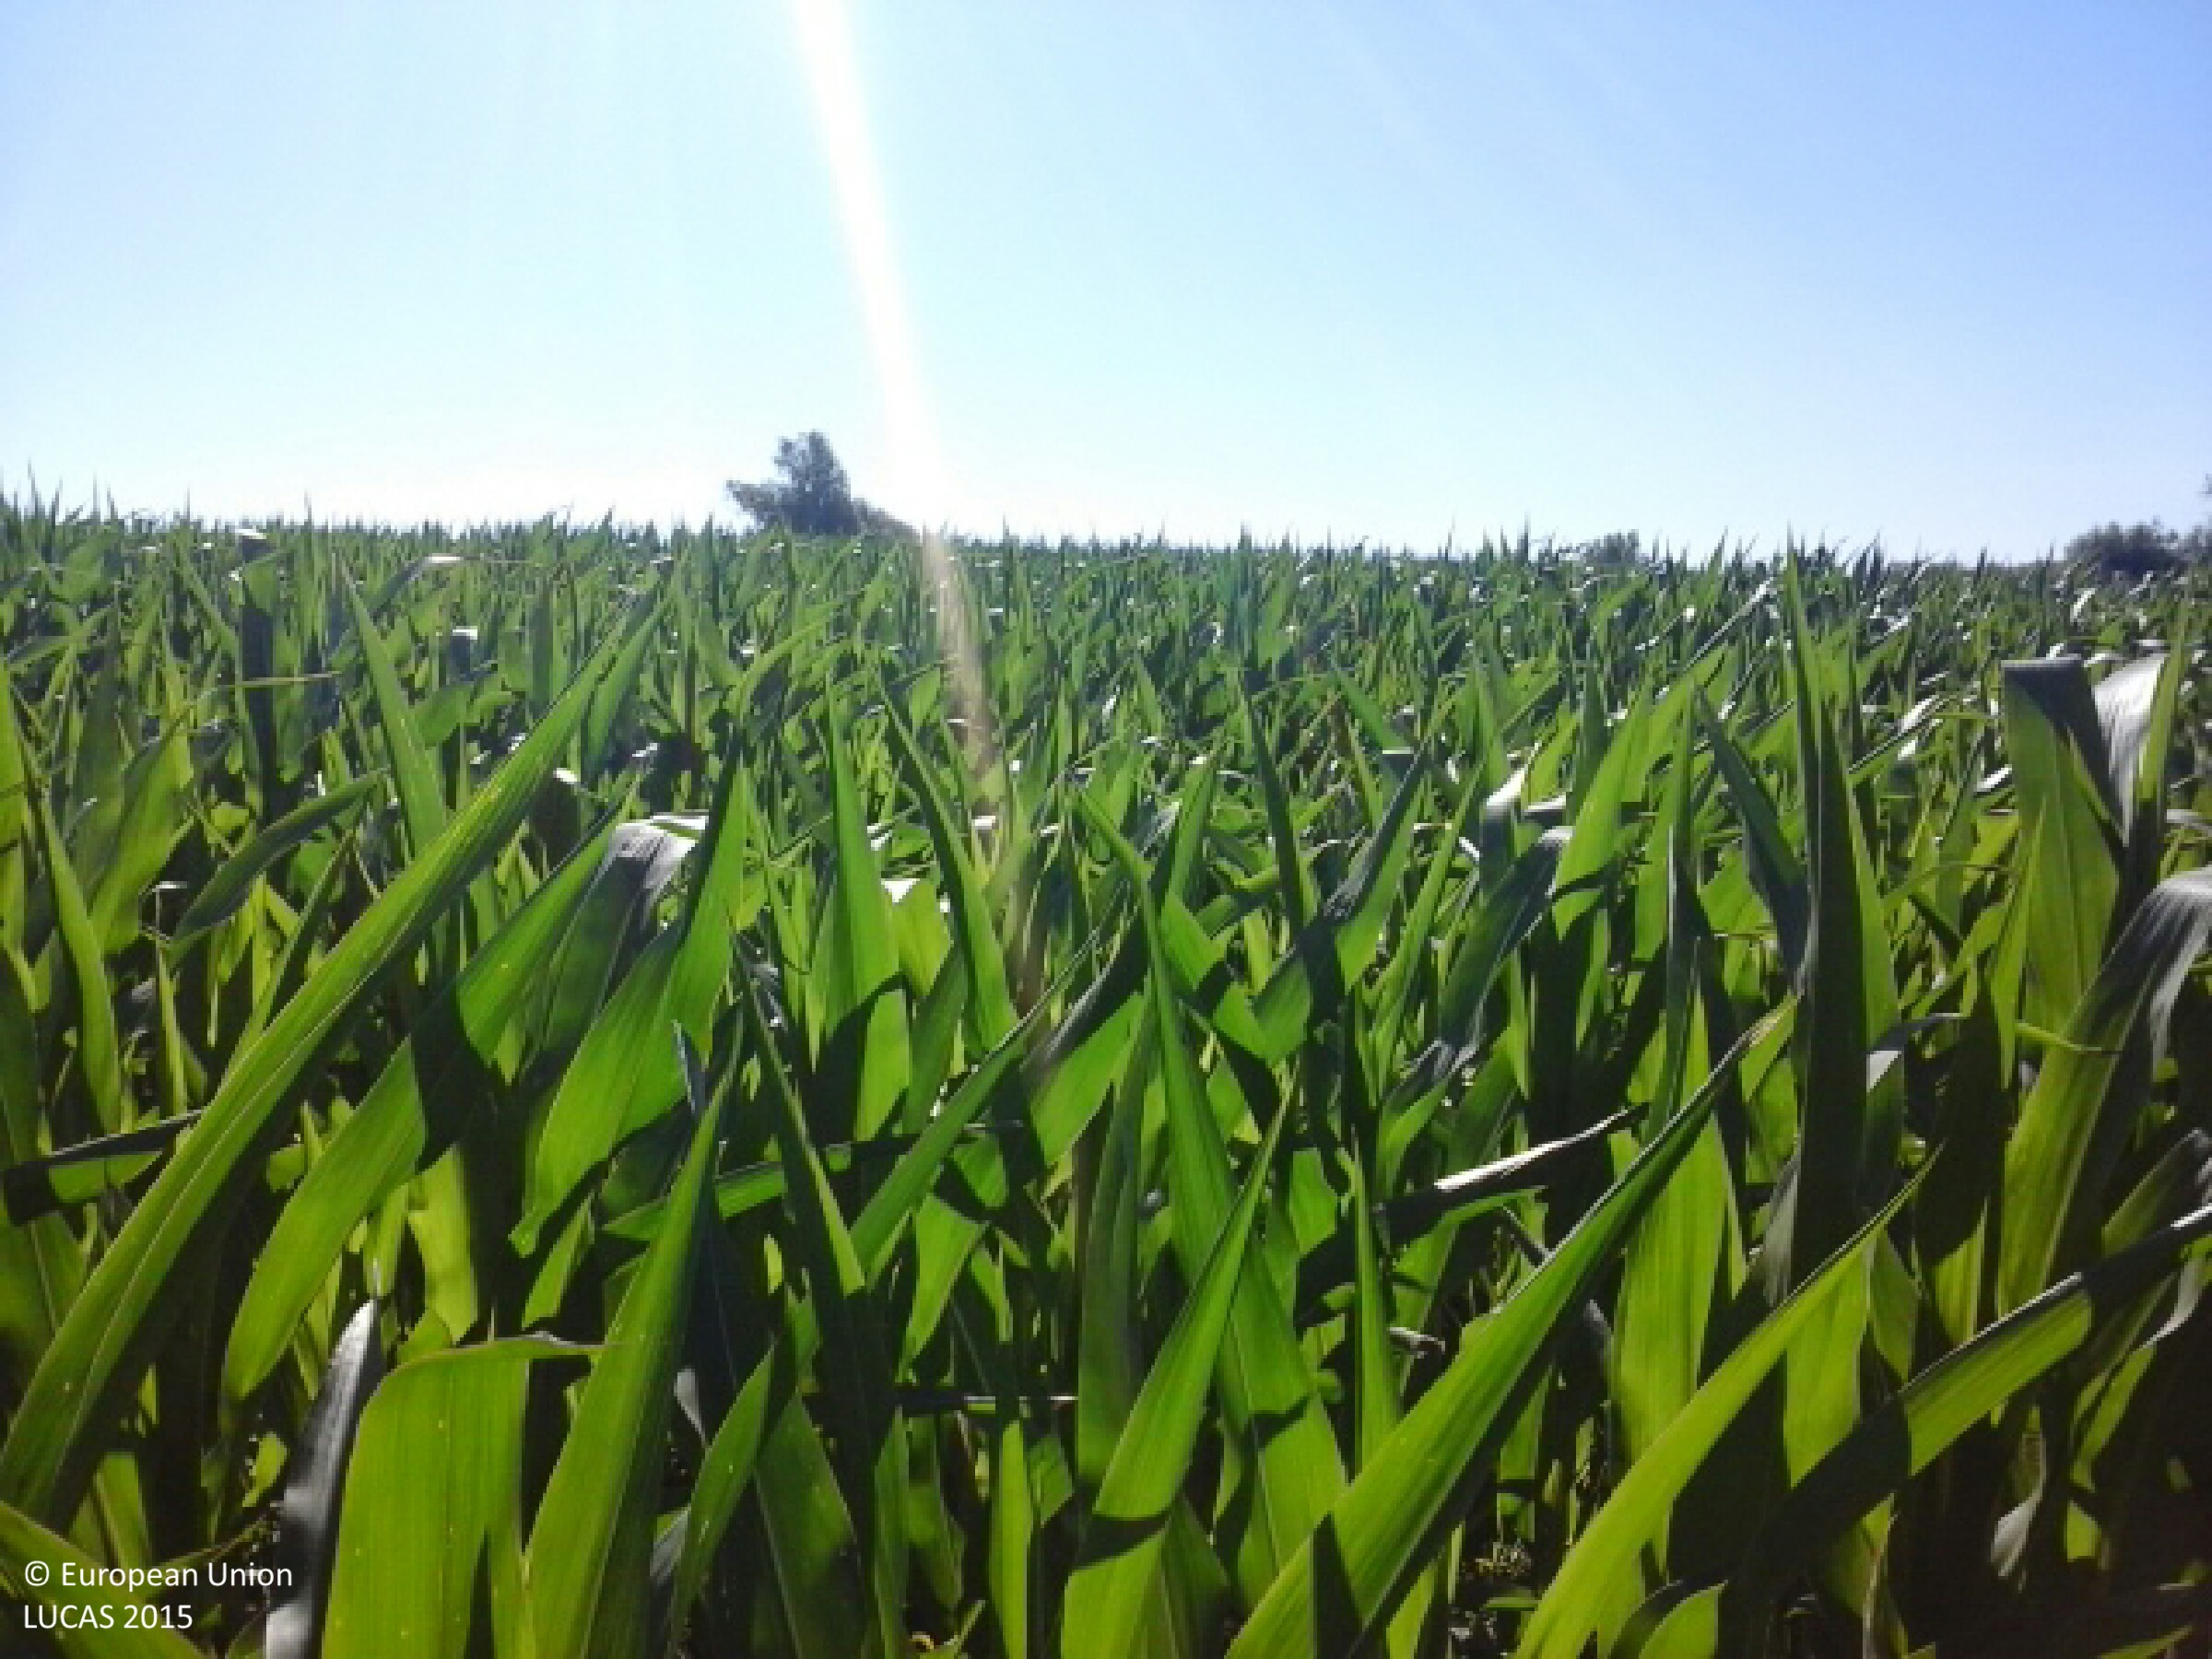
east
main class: Cropland
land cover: Maize
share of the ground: > 75 %
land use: Agriculture (excluding fallow land and kitchen gardens)
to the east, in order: Maize; Grassland without tree/shrub cover; Broadleaved woodland; Inland marshes; Broadleaved woodland; Maize
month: July
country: HU
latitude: 48.2033
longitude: 21.9877
